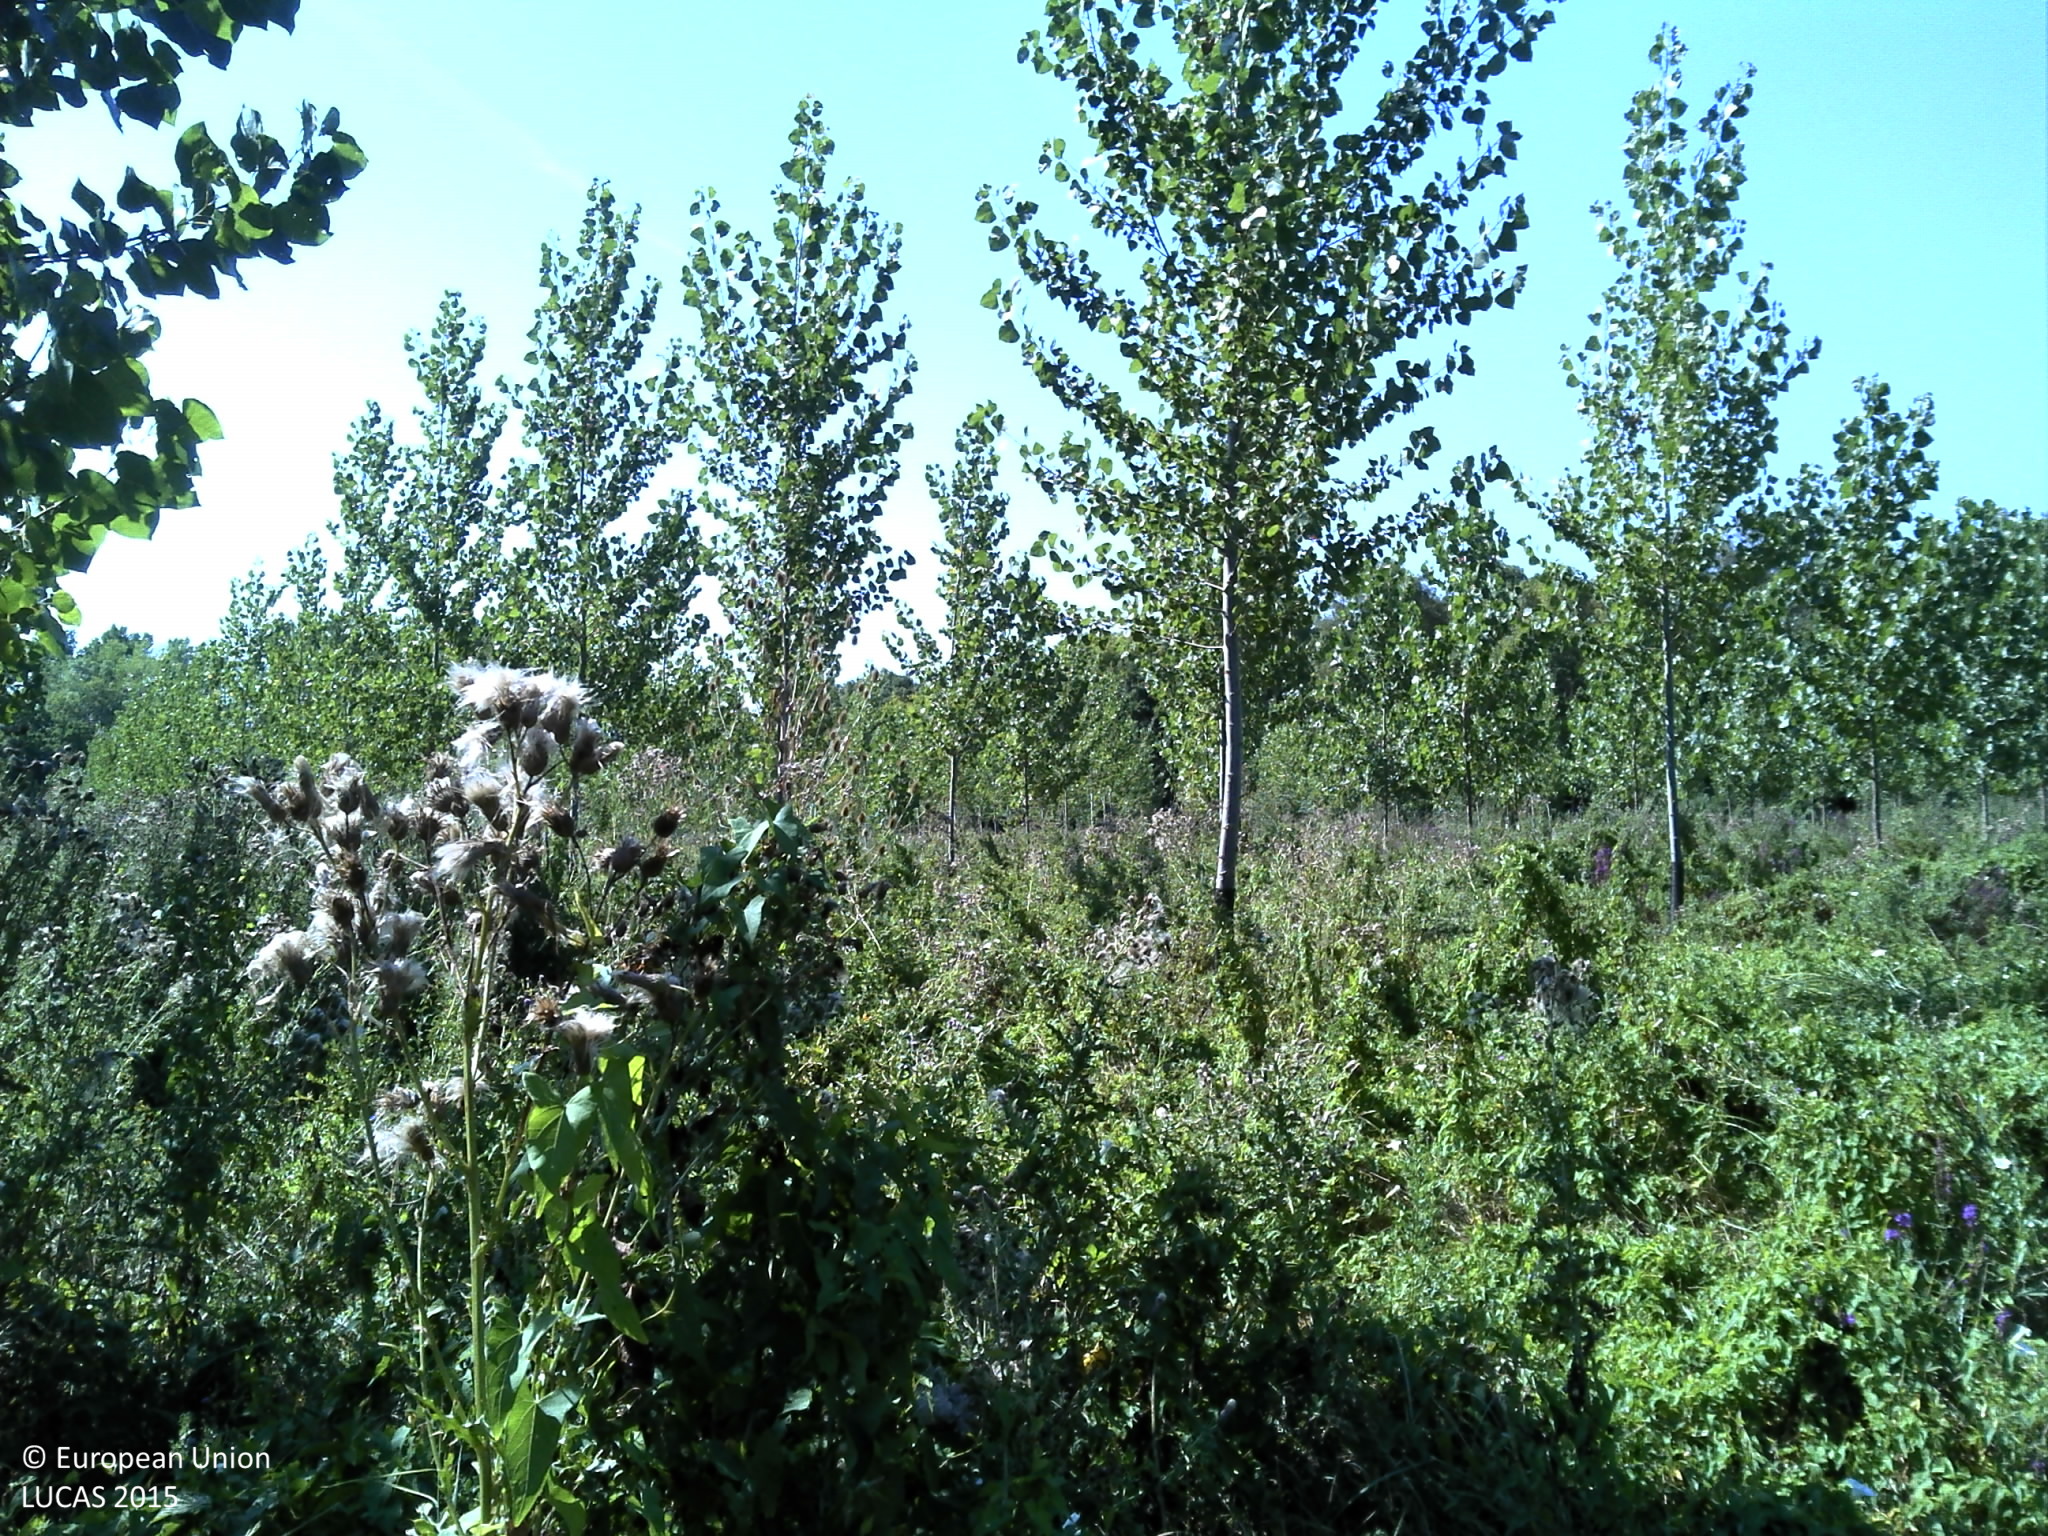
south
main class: Woodland
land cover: Broadleaved woodland
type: exotic forest
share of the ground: > 75 %
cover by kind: shrubs 40 %, herbaceous plants 40 %, broadleaved forest trees 20 %
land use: Forestry
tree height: < 5 m
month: August
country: FR
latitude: 45.0678
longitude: -0.7025
